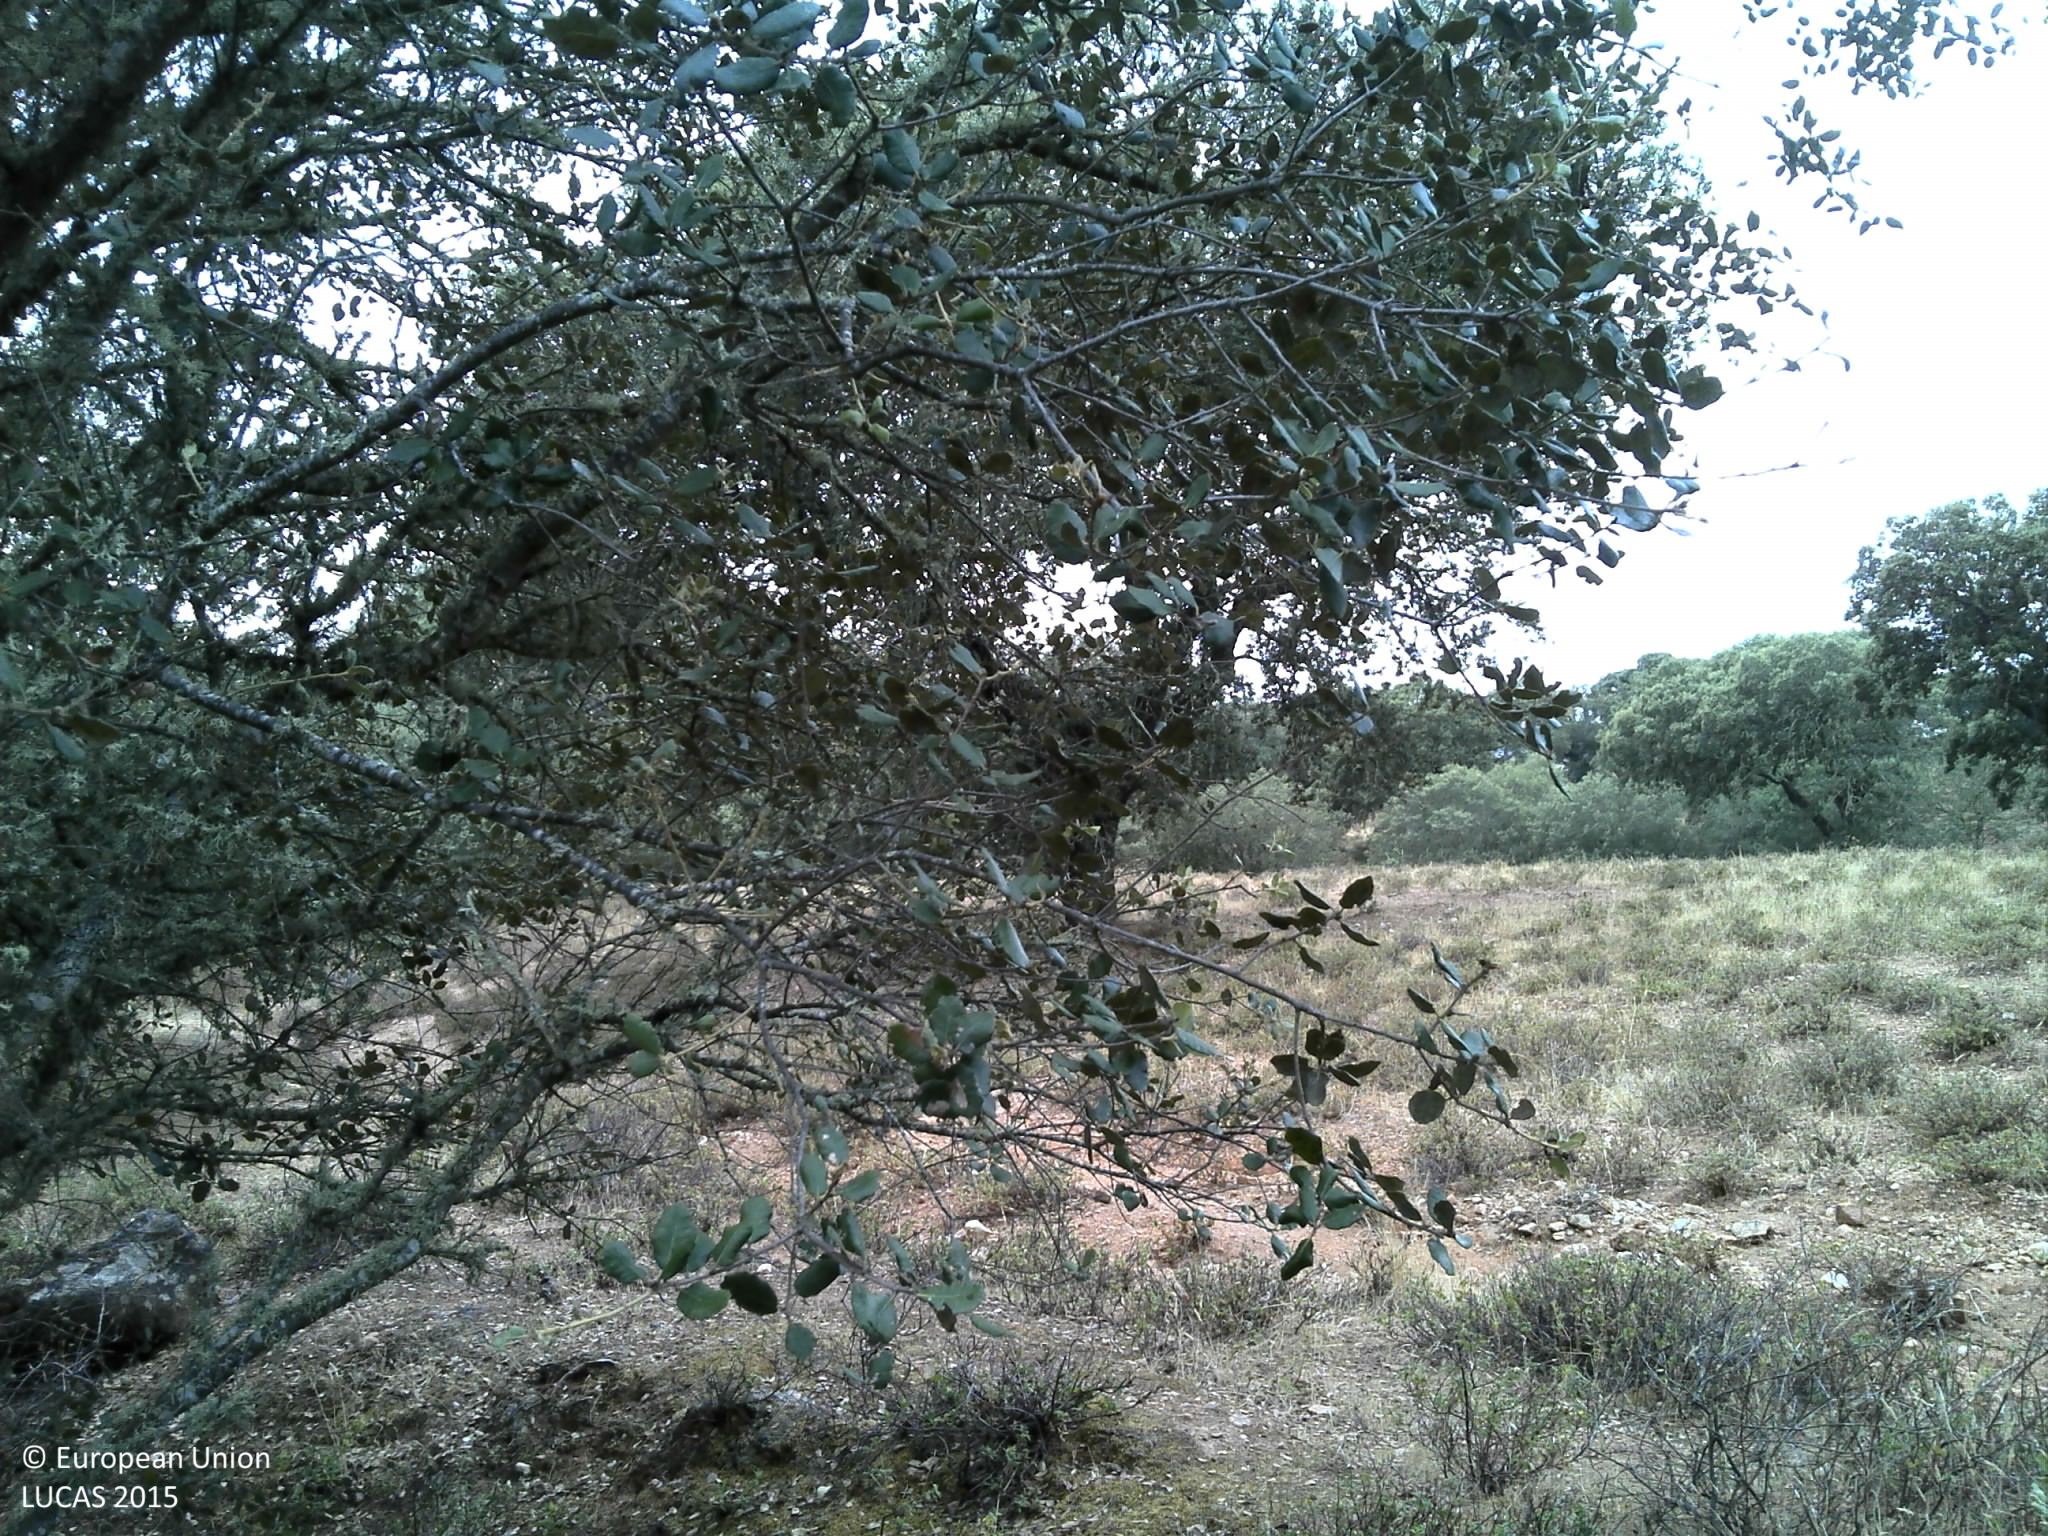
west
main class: Woodland
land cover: Broadleaved woodland
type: broadleaved evergreen forest
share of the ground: 25 - 50 %
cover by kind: broadleaved forest trees 50 %, shrubs 20 %, herbaceous plants 20 %, unconsolidated bare surface 10 %
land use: Forestry
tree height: > 5 m
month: June
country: PT
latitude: 38.6754
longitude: -7.7269
